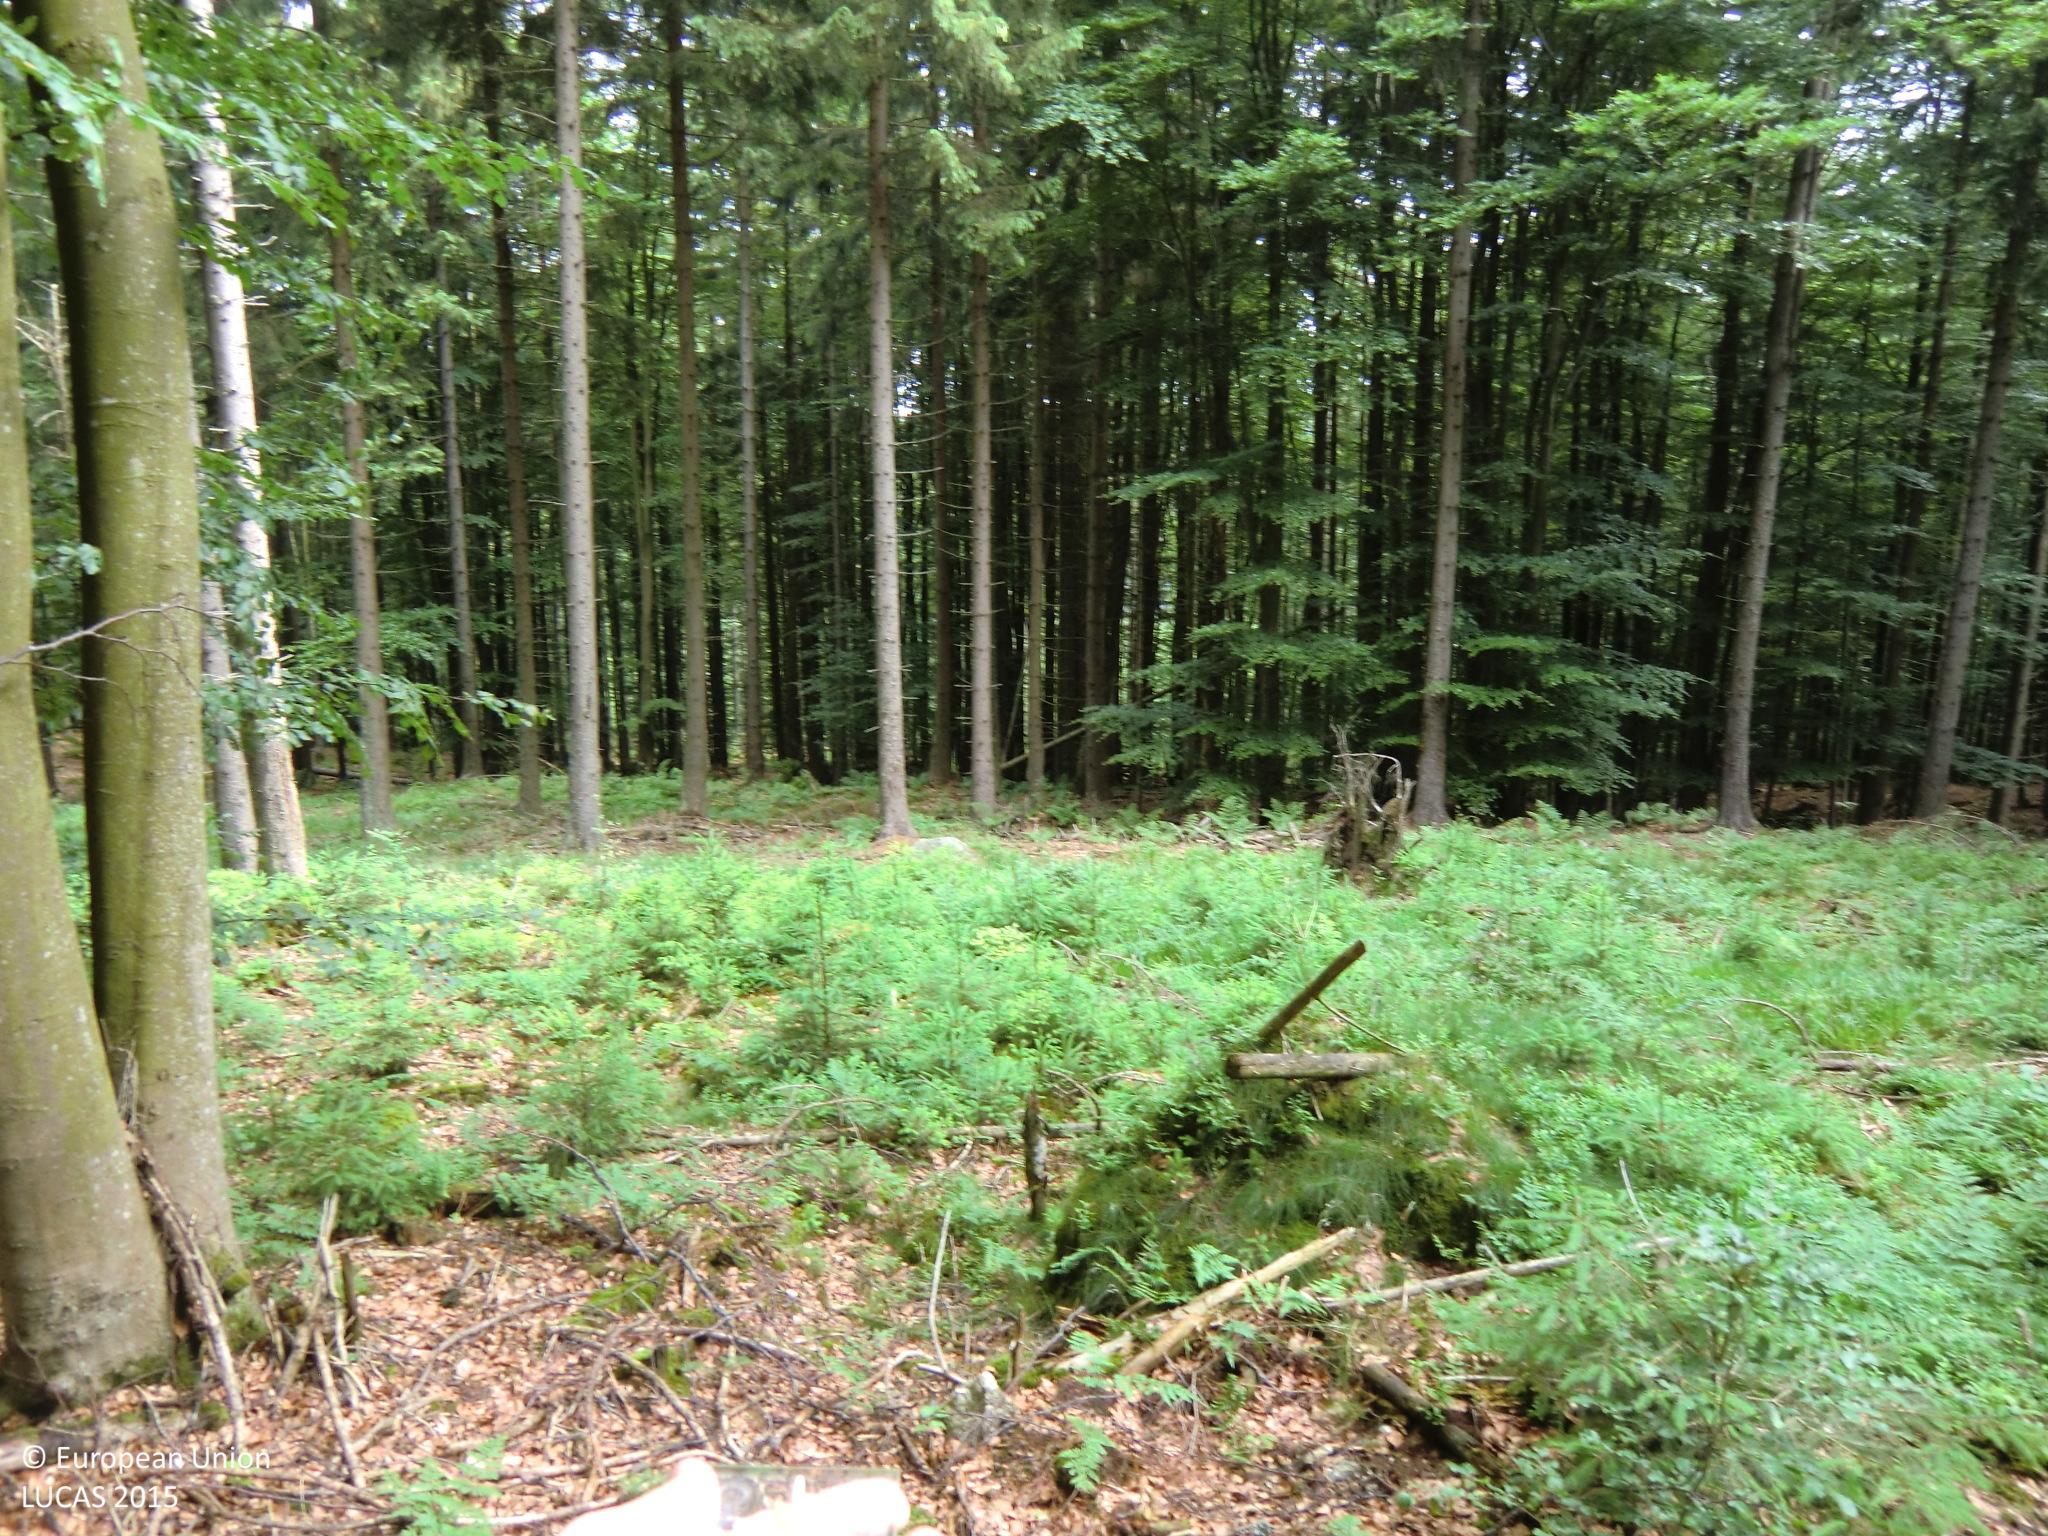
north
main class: Woodland
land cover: Spruce dominated mixed woodland
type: mountainous beech forest
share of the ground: > 75 %
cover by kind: coniferous forest trees 40 %, broadleaved forest trees 40 %, shrubs 10 %, herbaceous plants 5 %, unconsolidated bare surface 5 %
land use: Forestry
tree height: > 5 m
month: June
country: AT
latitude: 48.3250
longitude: 15.0322
